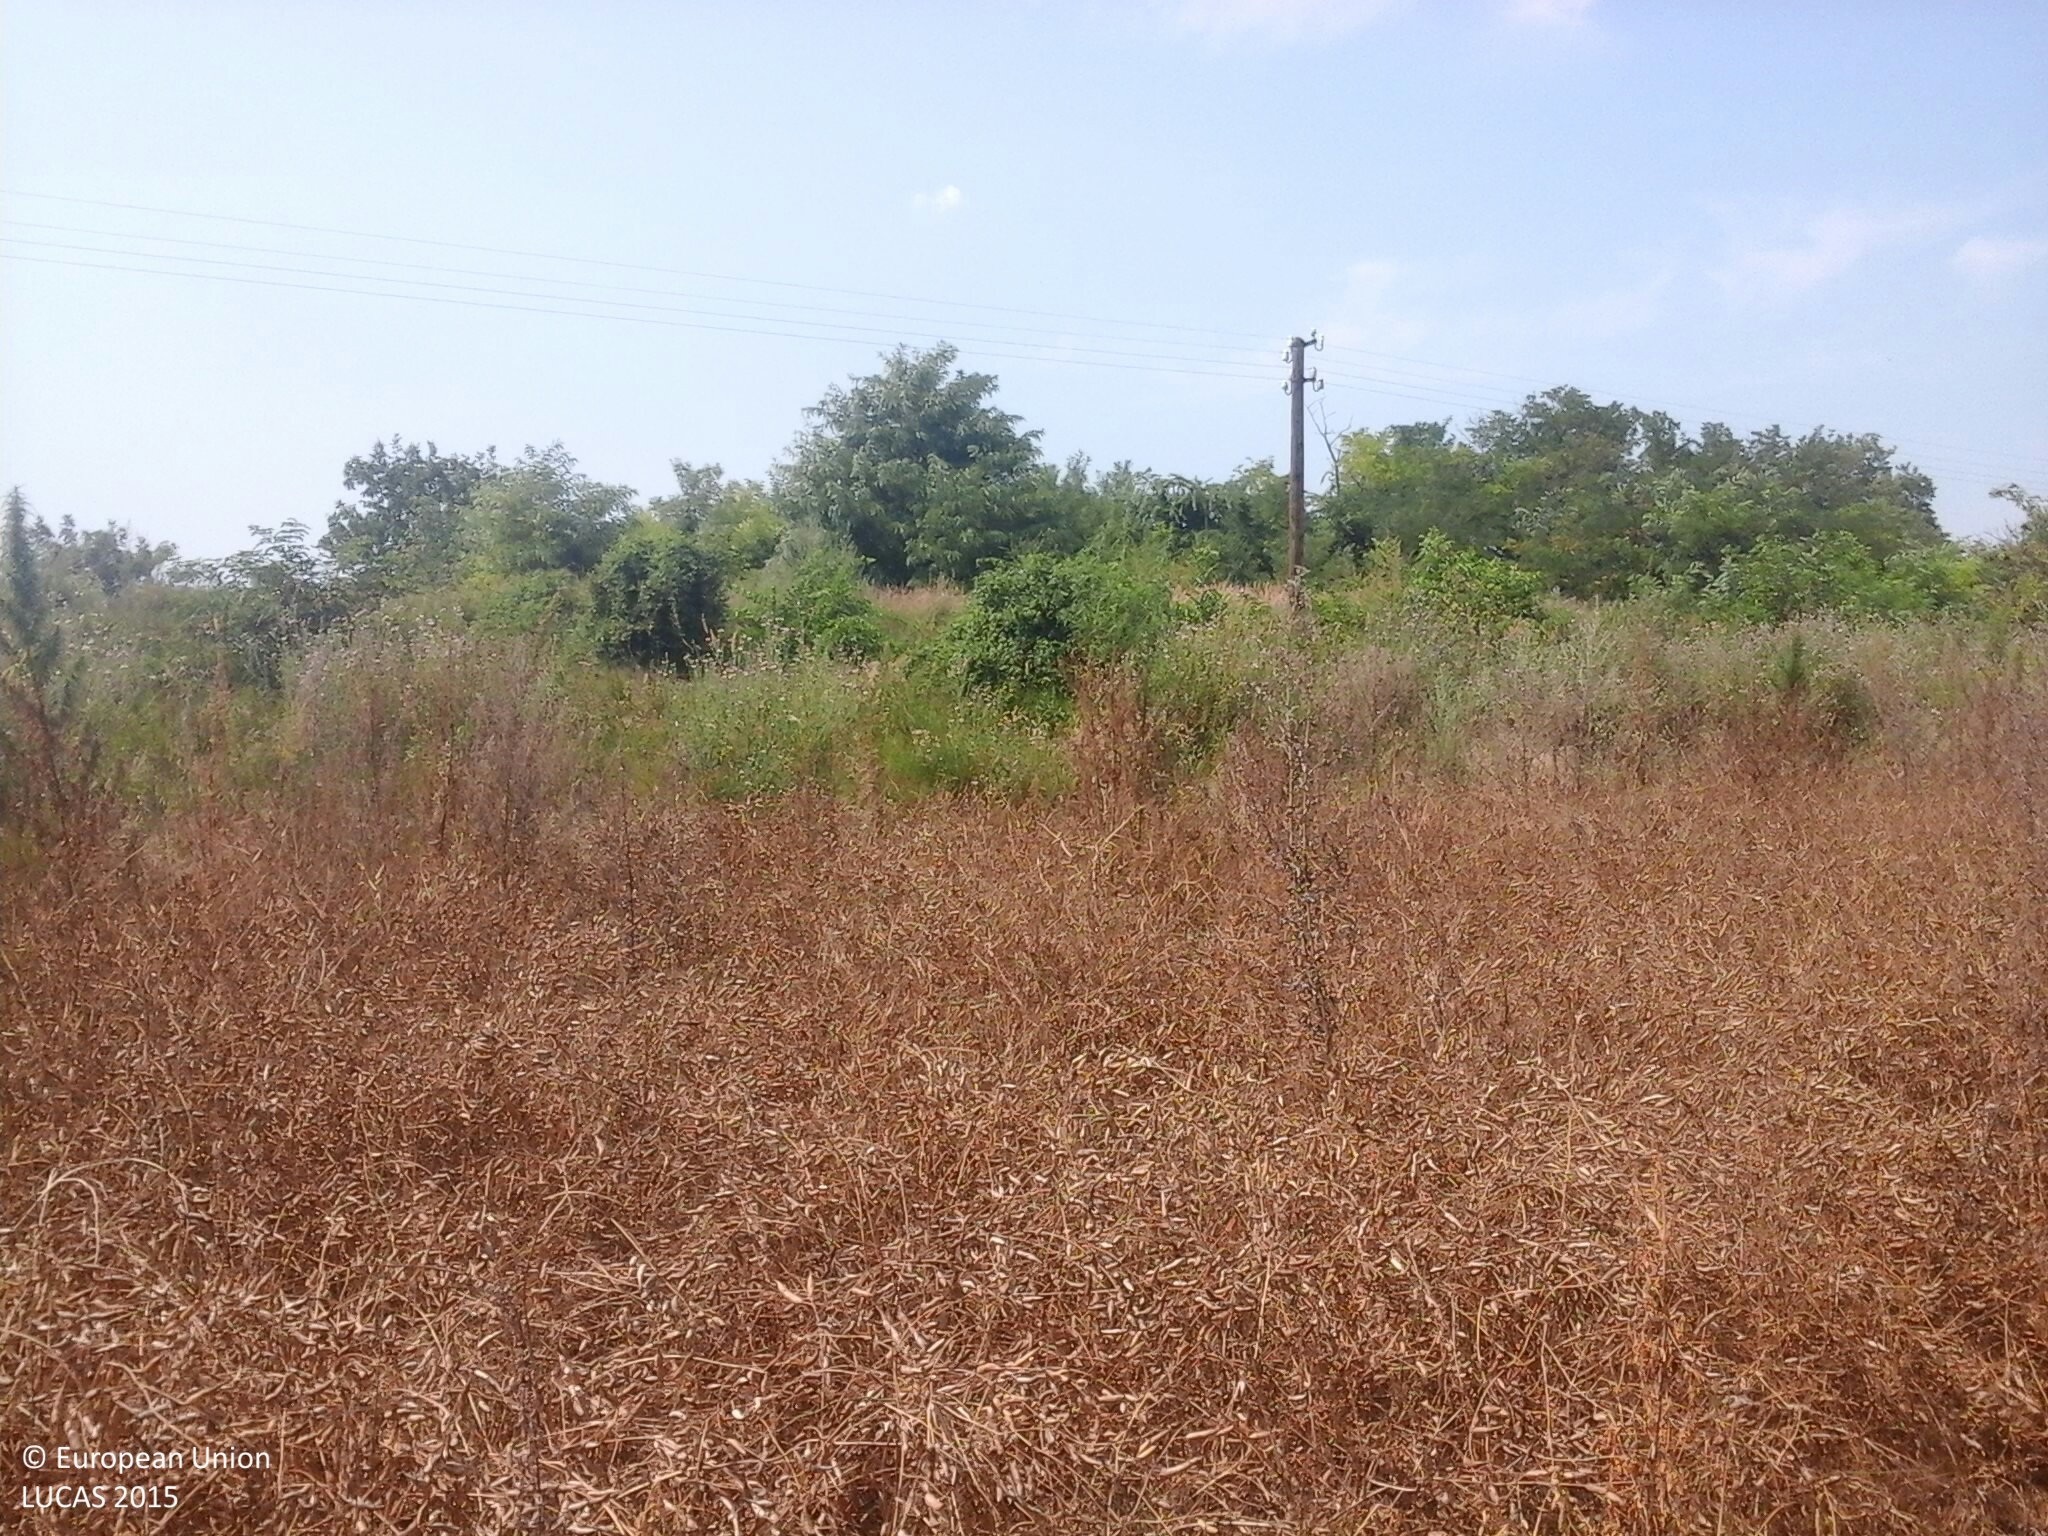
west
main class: Cropland
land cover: Other fibre and oleaginous crops
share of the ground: > 75 %
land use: Agriculture (excluding fallow land and kitchen gardens)
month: August
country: HU
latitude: 46.8737
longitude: 18.1309
